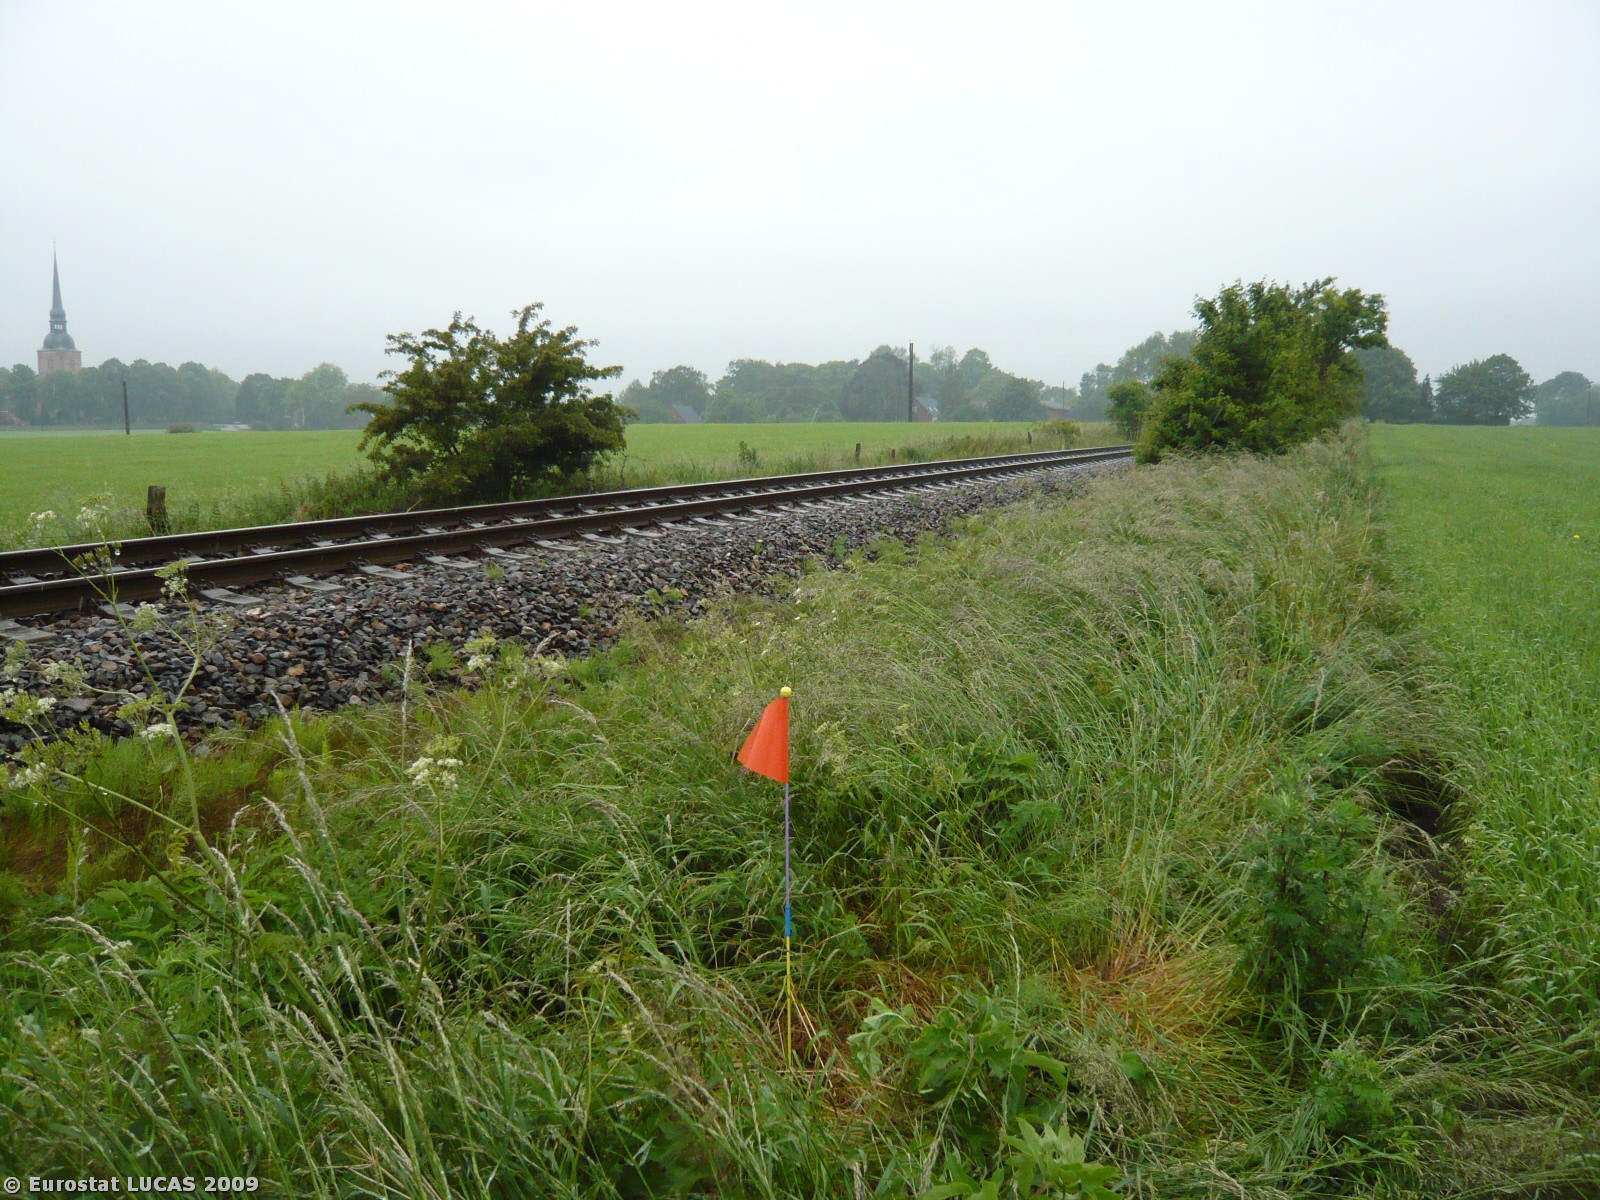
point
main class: Grassland
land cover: Grassland without tree/shrub cover
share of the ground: > 75 %
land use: Railway transport
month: June
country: DK
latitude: 54.7923
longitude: 11.6941
